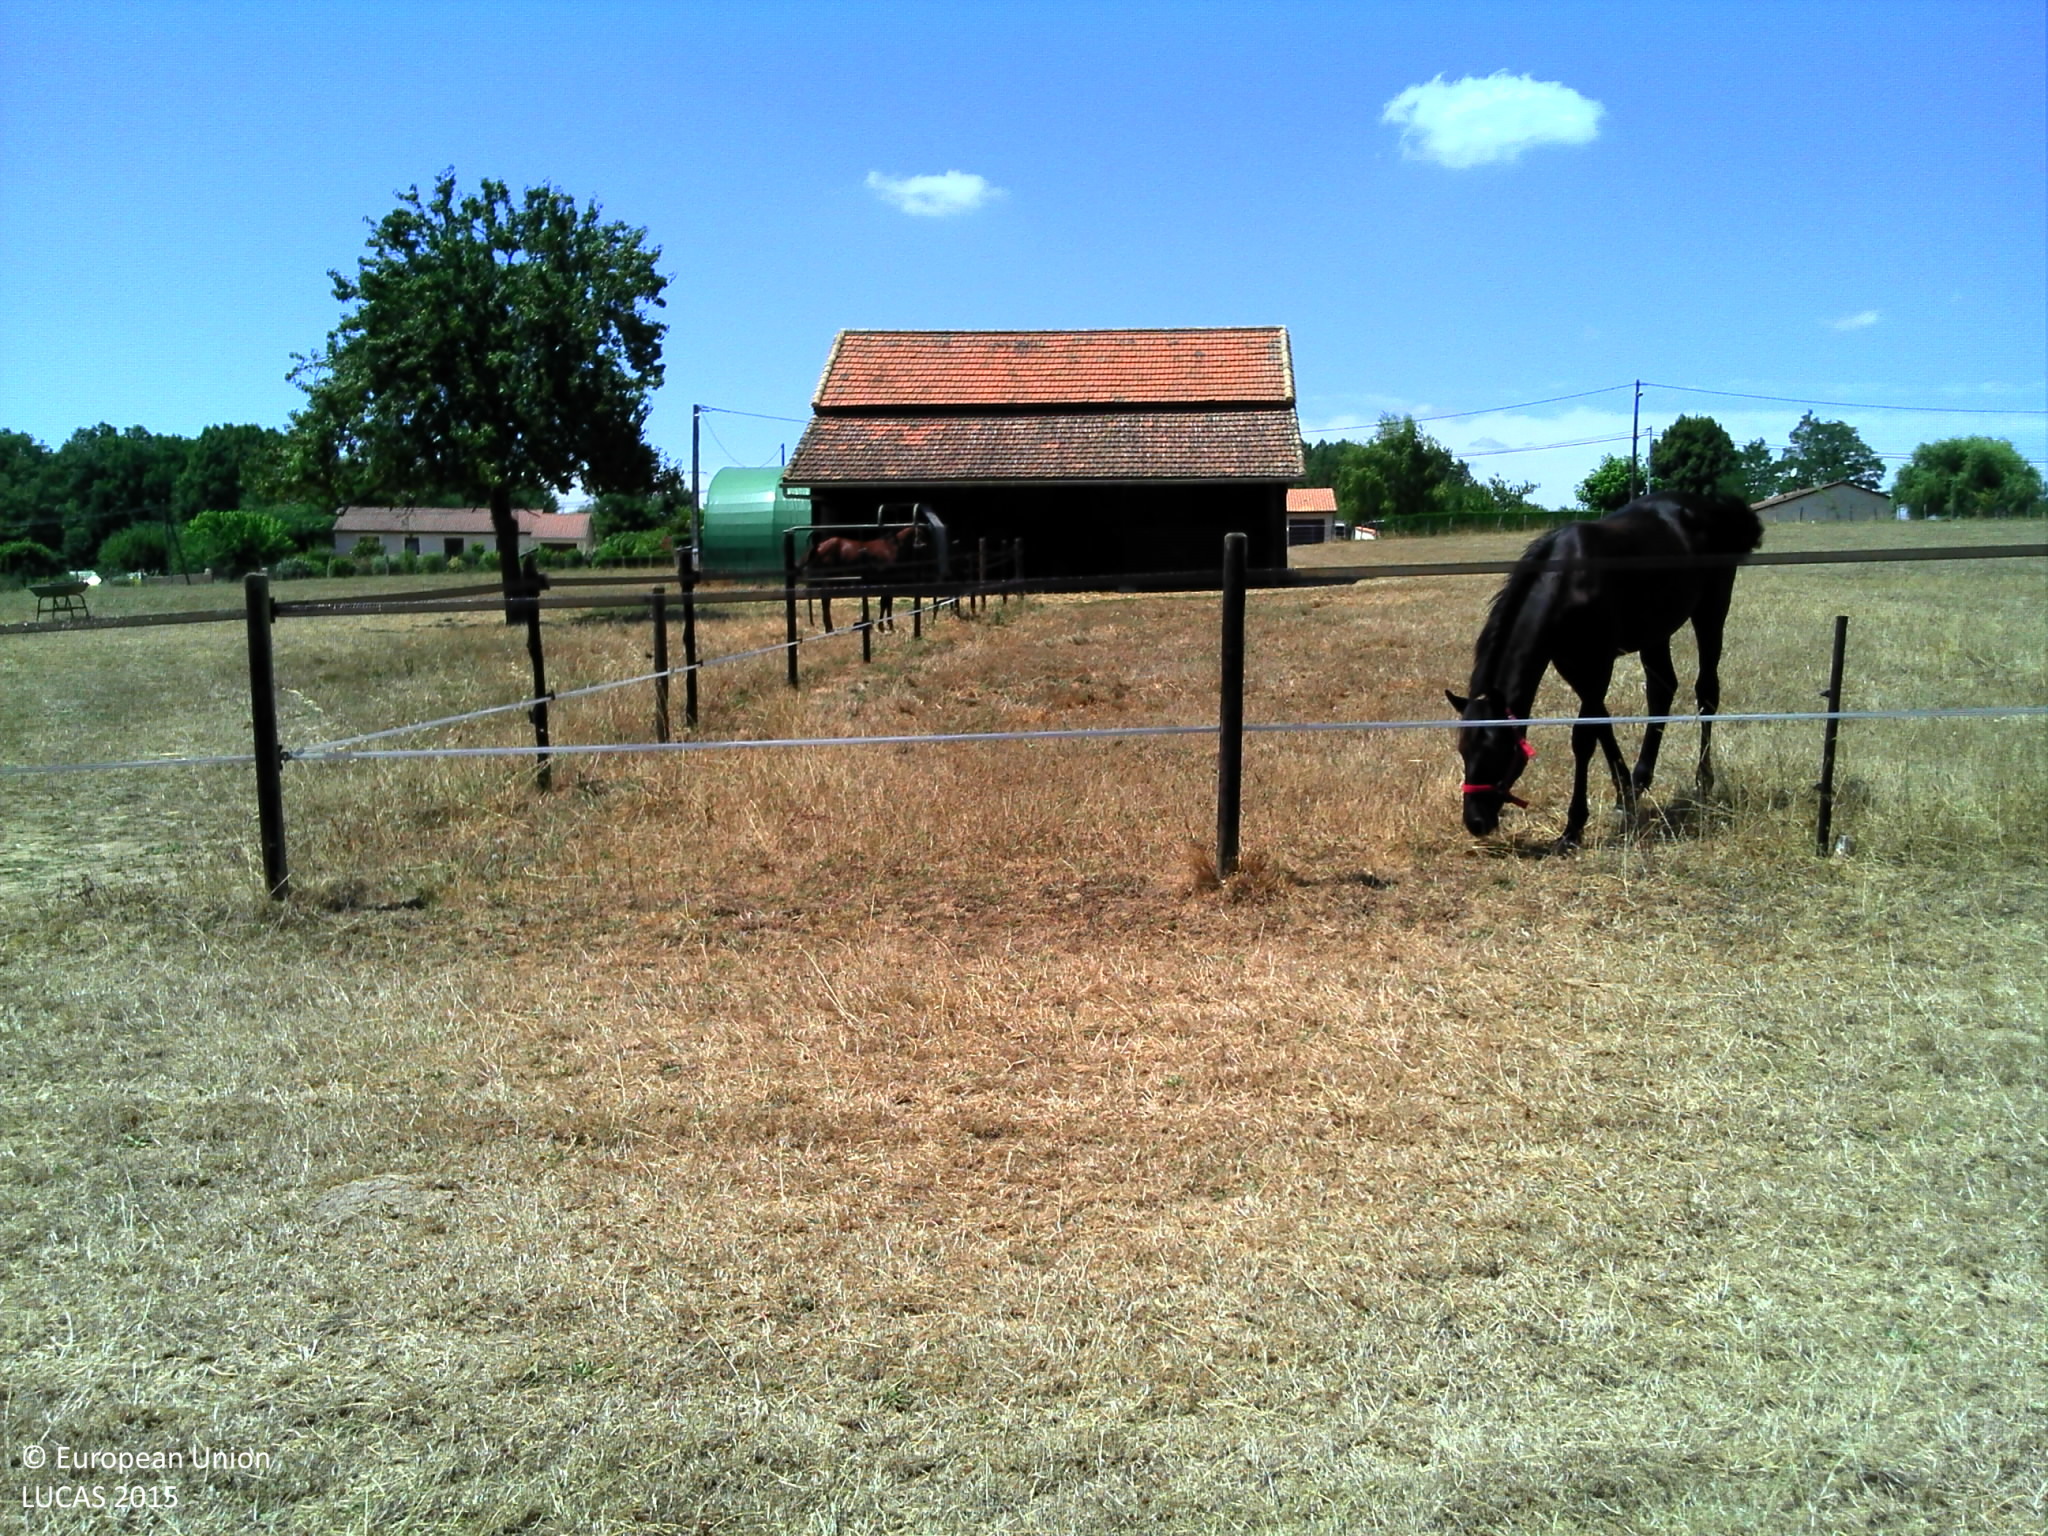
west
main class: Grassland
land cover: Grassland without tree/shrub cover
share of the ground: > 75 %
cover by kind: herbaceous plants 100 %
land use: Agriculture (excluding fallow land and kitchen gardens)
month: July
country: FR
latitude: 44.8654
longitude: 0.5872
